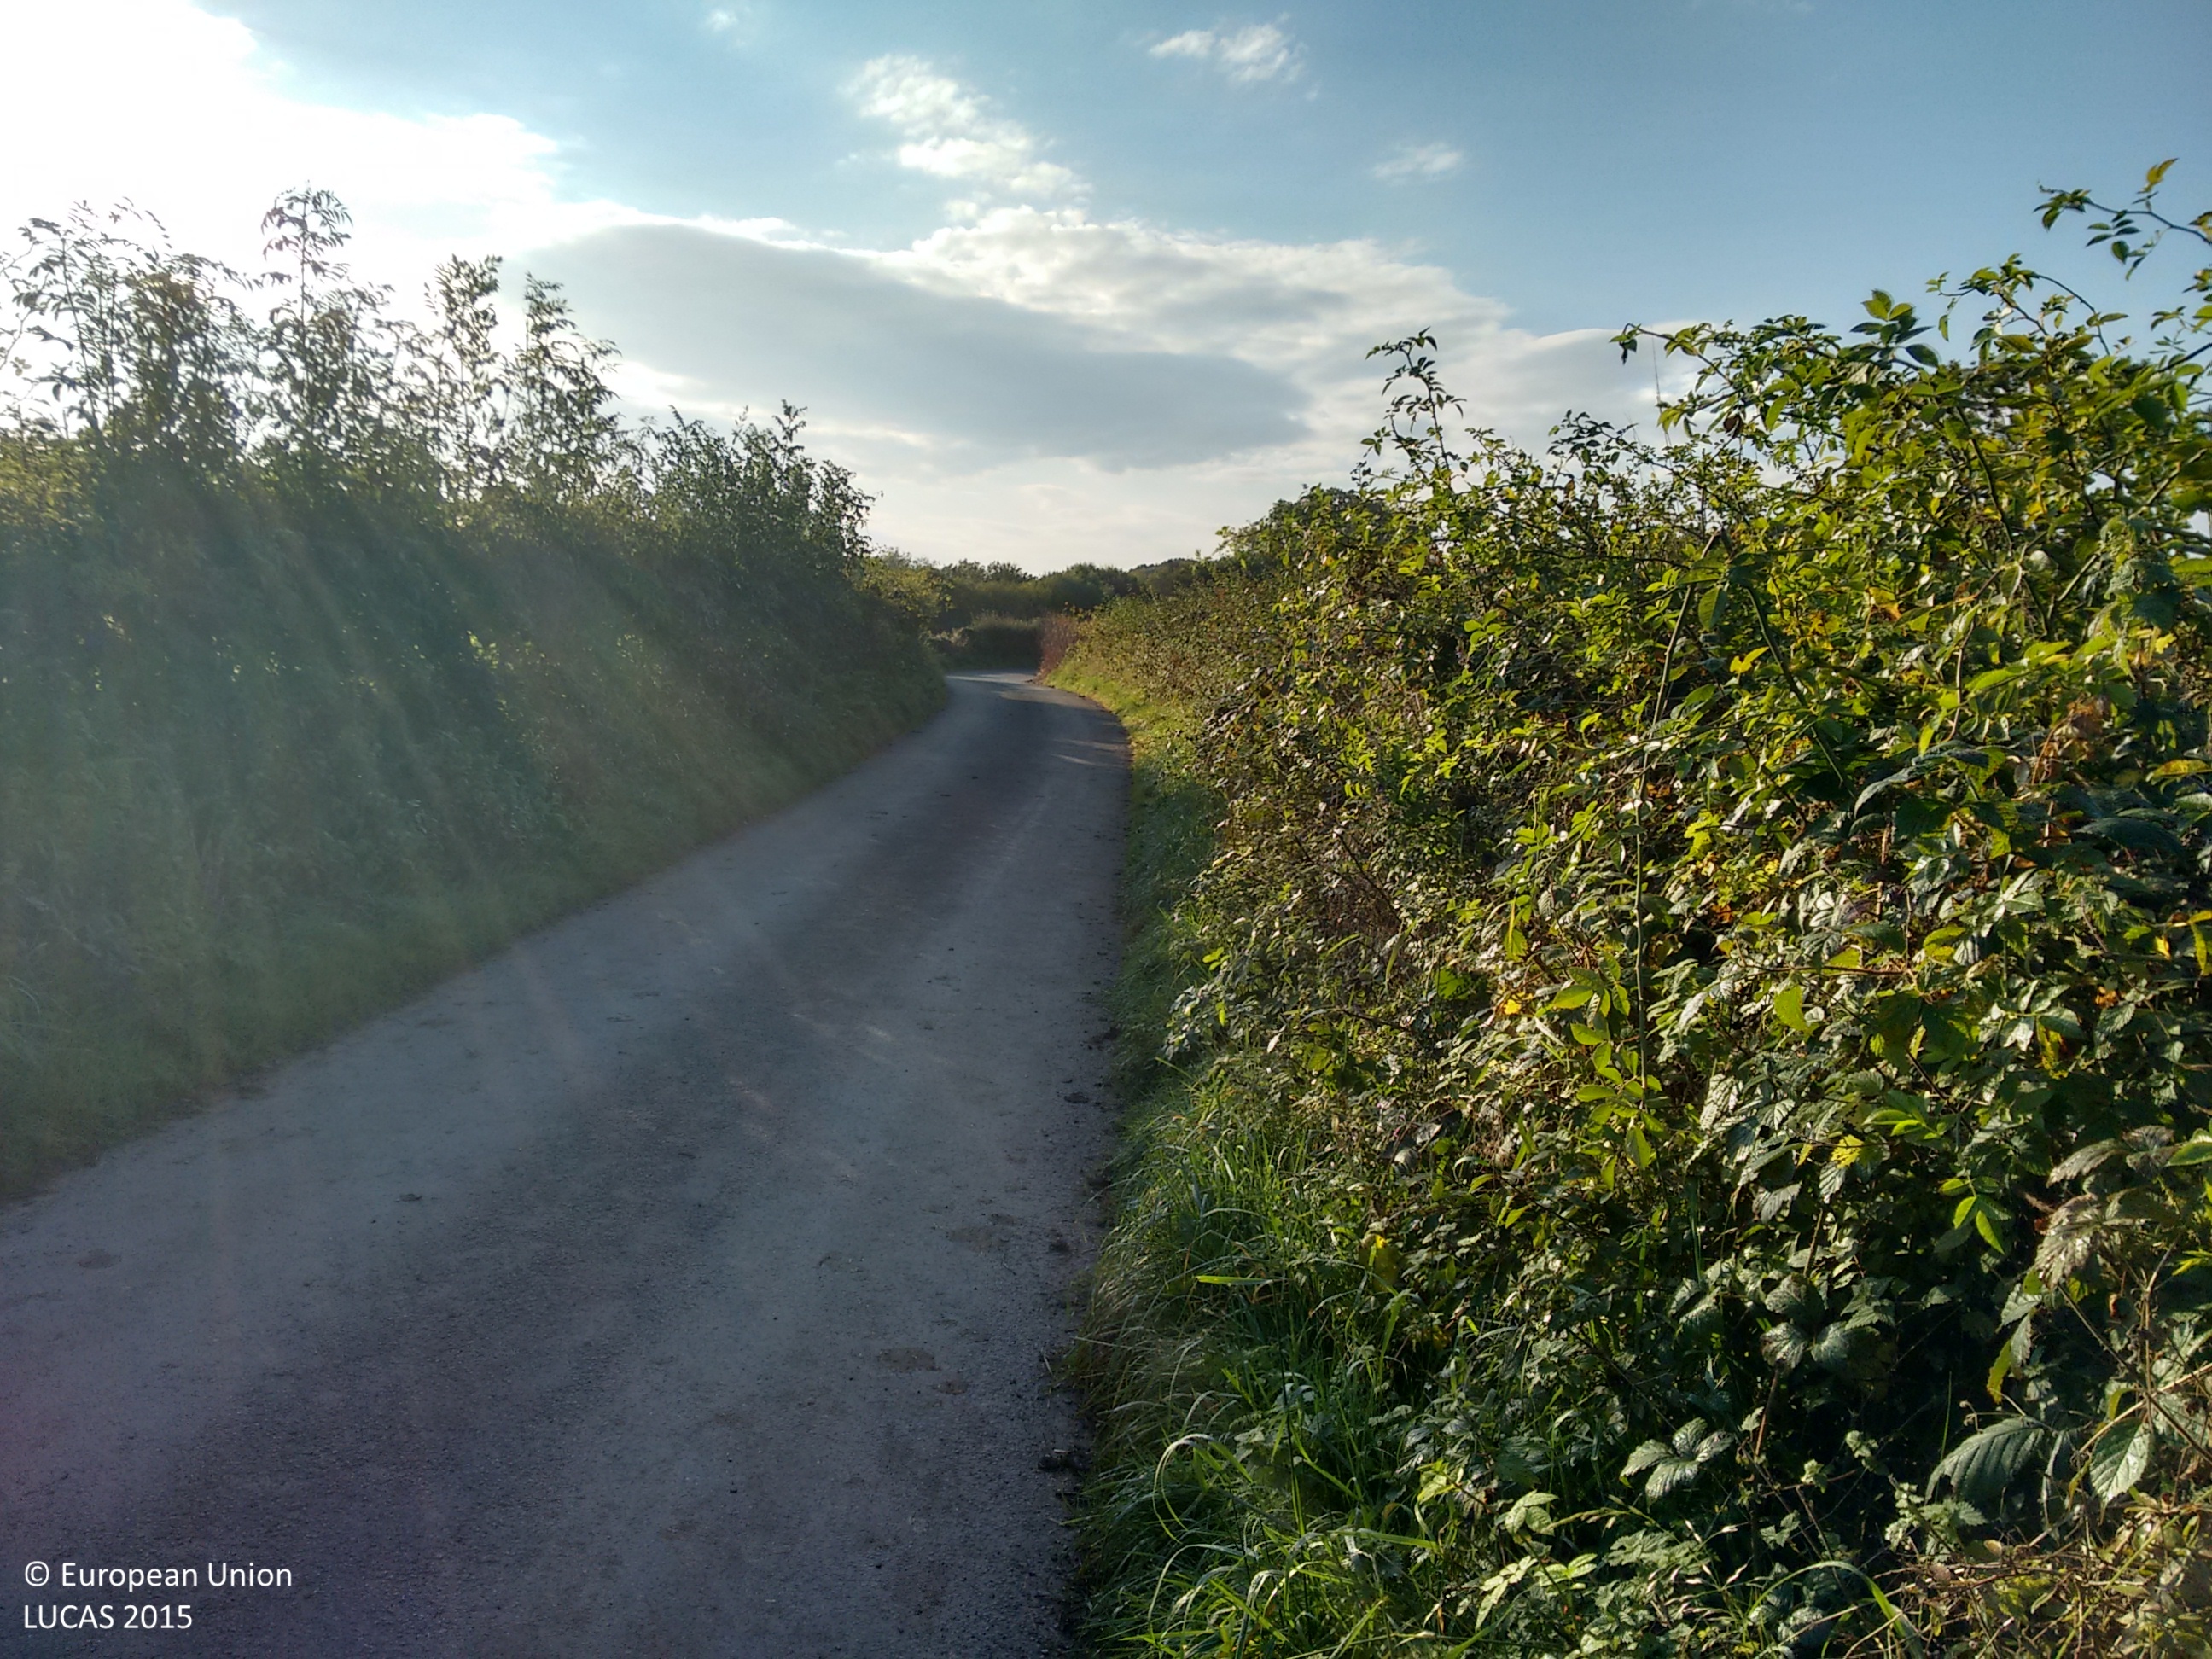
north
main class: Grassland
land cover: Grassland without tree/shrub cover
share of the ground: > 75 %
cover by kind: herbaceous plants 100 %
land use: Agriculture (excluding fallow land and kitchen gardens)
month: October
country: GB
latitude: 54.2037
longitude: -3.0592
